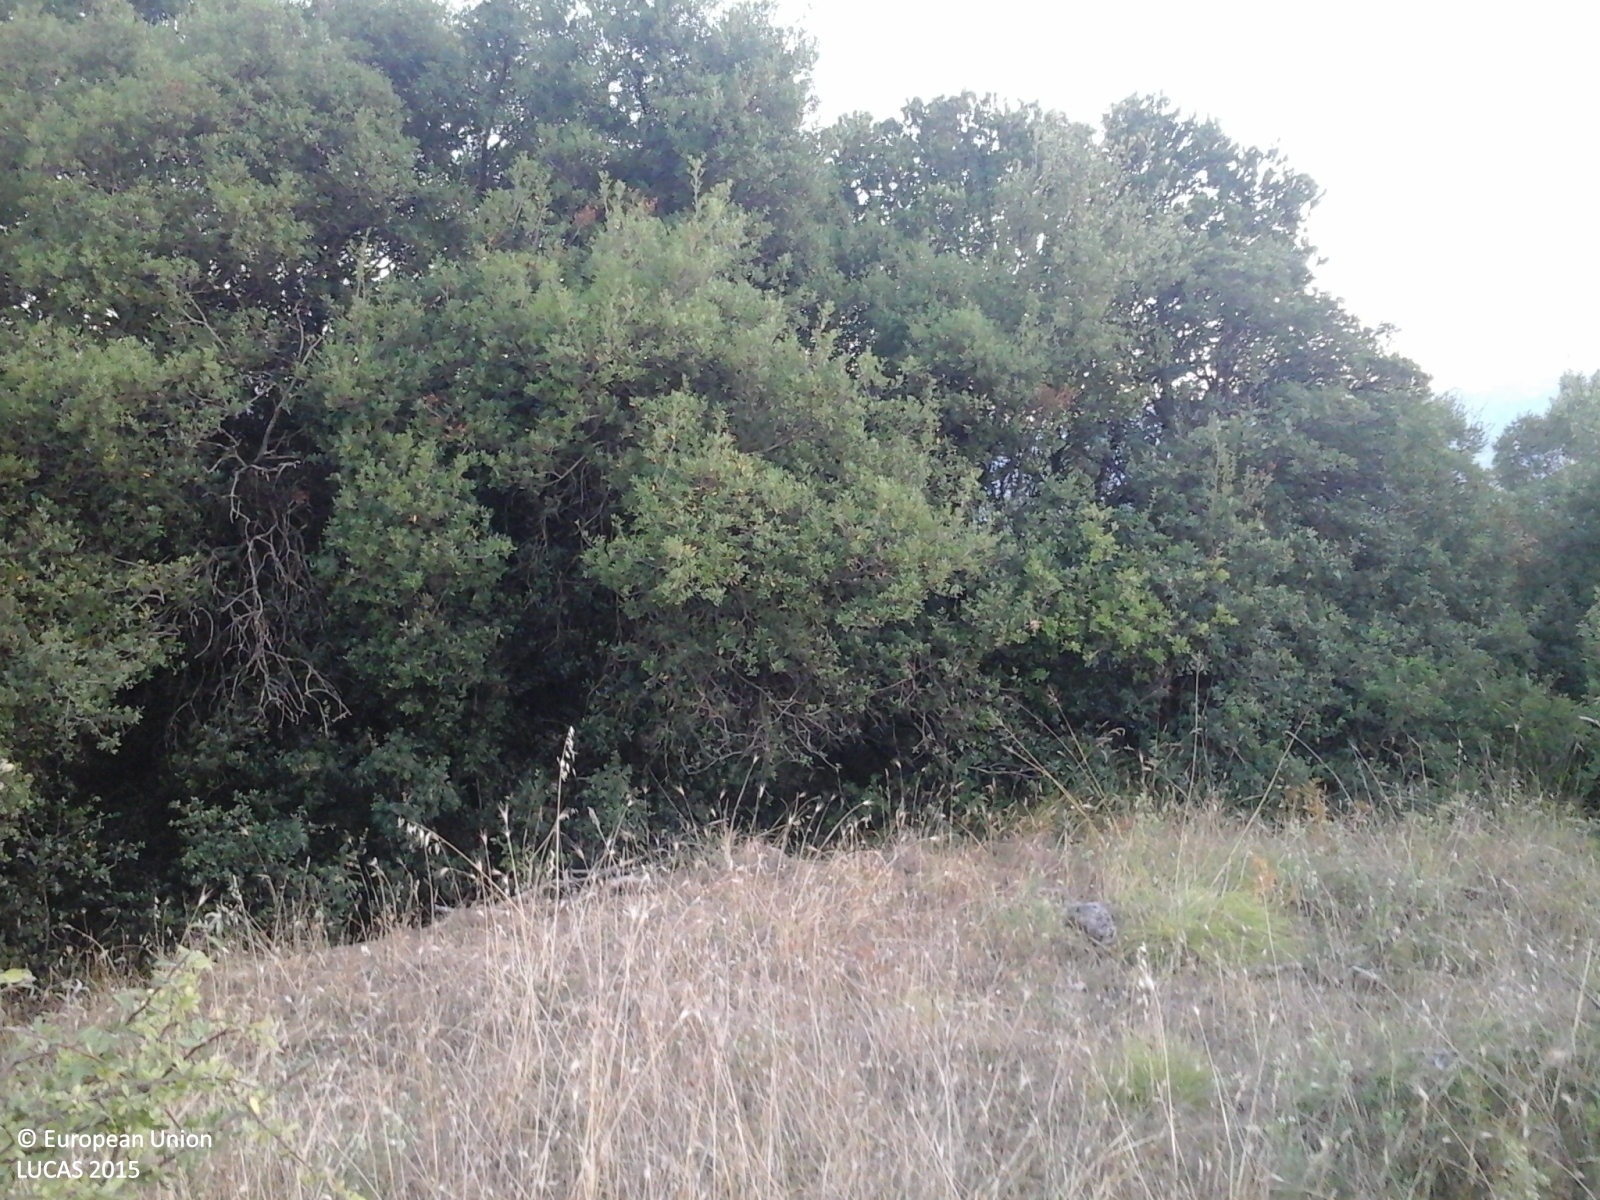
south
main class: Woodland
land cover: Broadleaved woodland
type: thermophilous deciduous forest
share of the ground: > 75 %
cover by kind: broadleaved forest trees 80 %, herbaceous plants 15 %, shrubs 5 %
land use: Forestry
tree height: > 5 m
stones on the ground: < 10 %
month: July
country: GR
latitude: 39.4024
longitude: 20.7401
